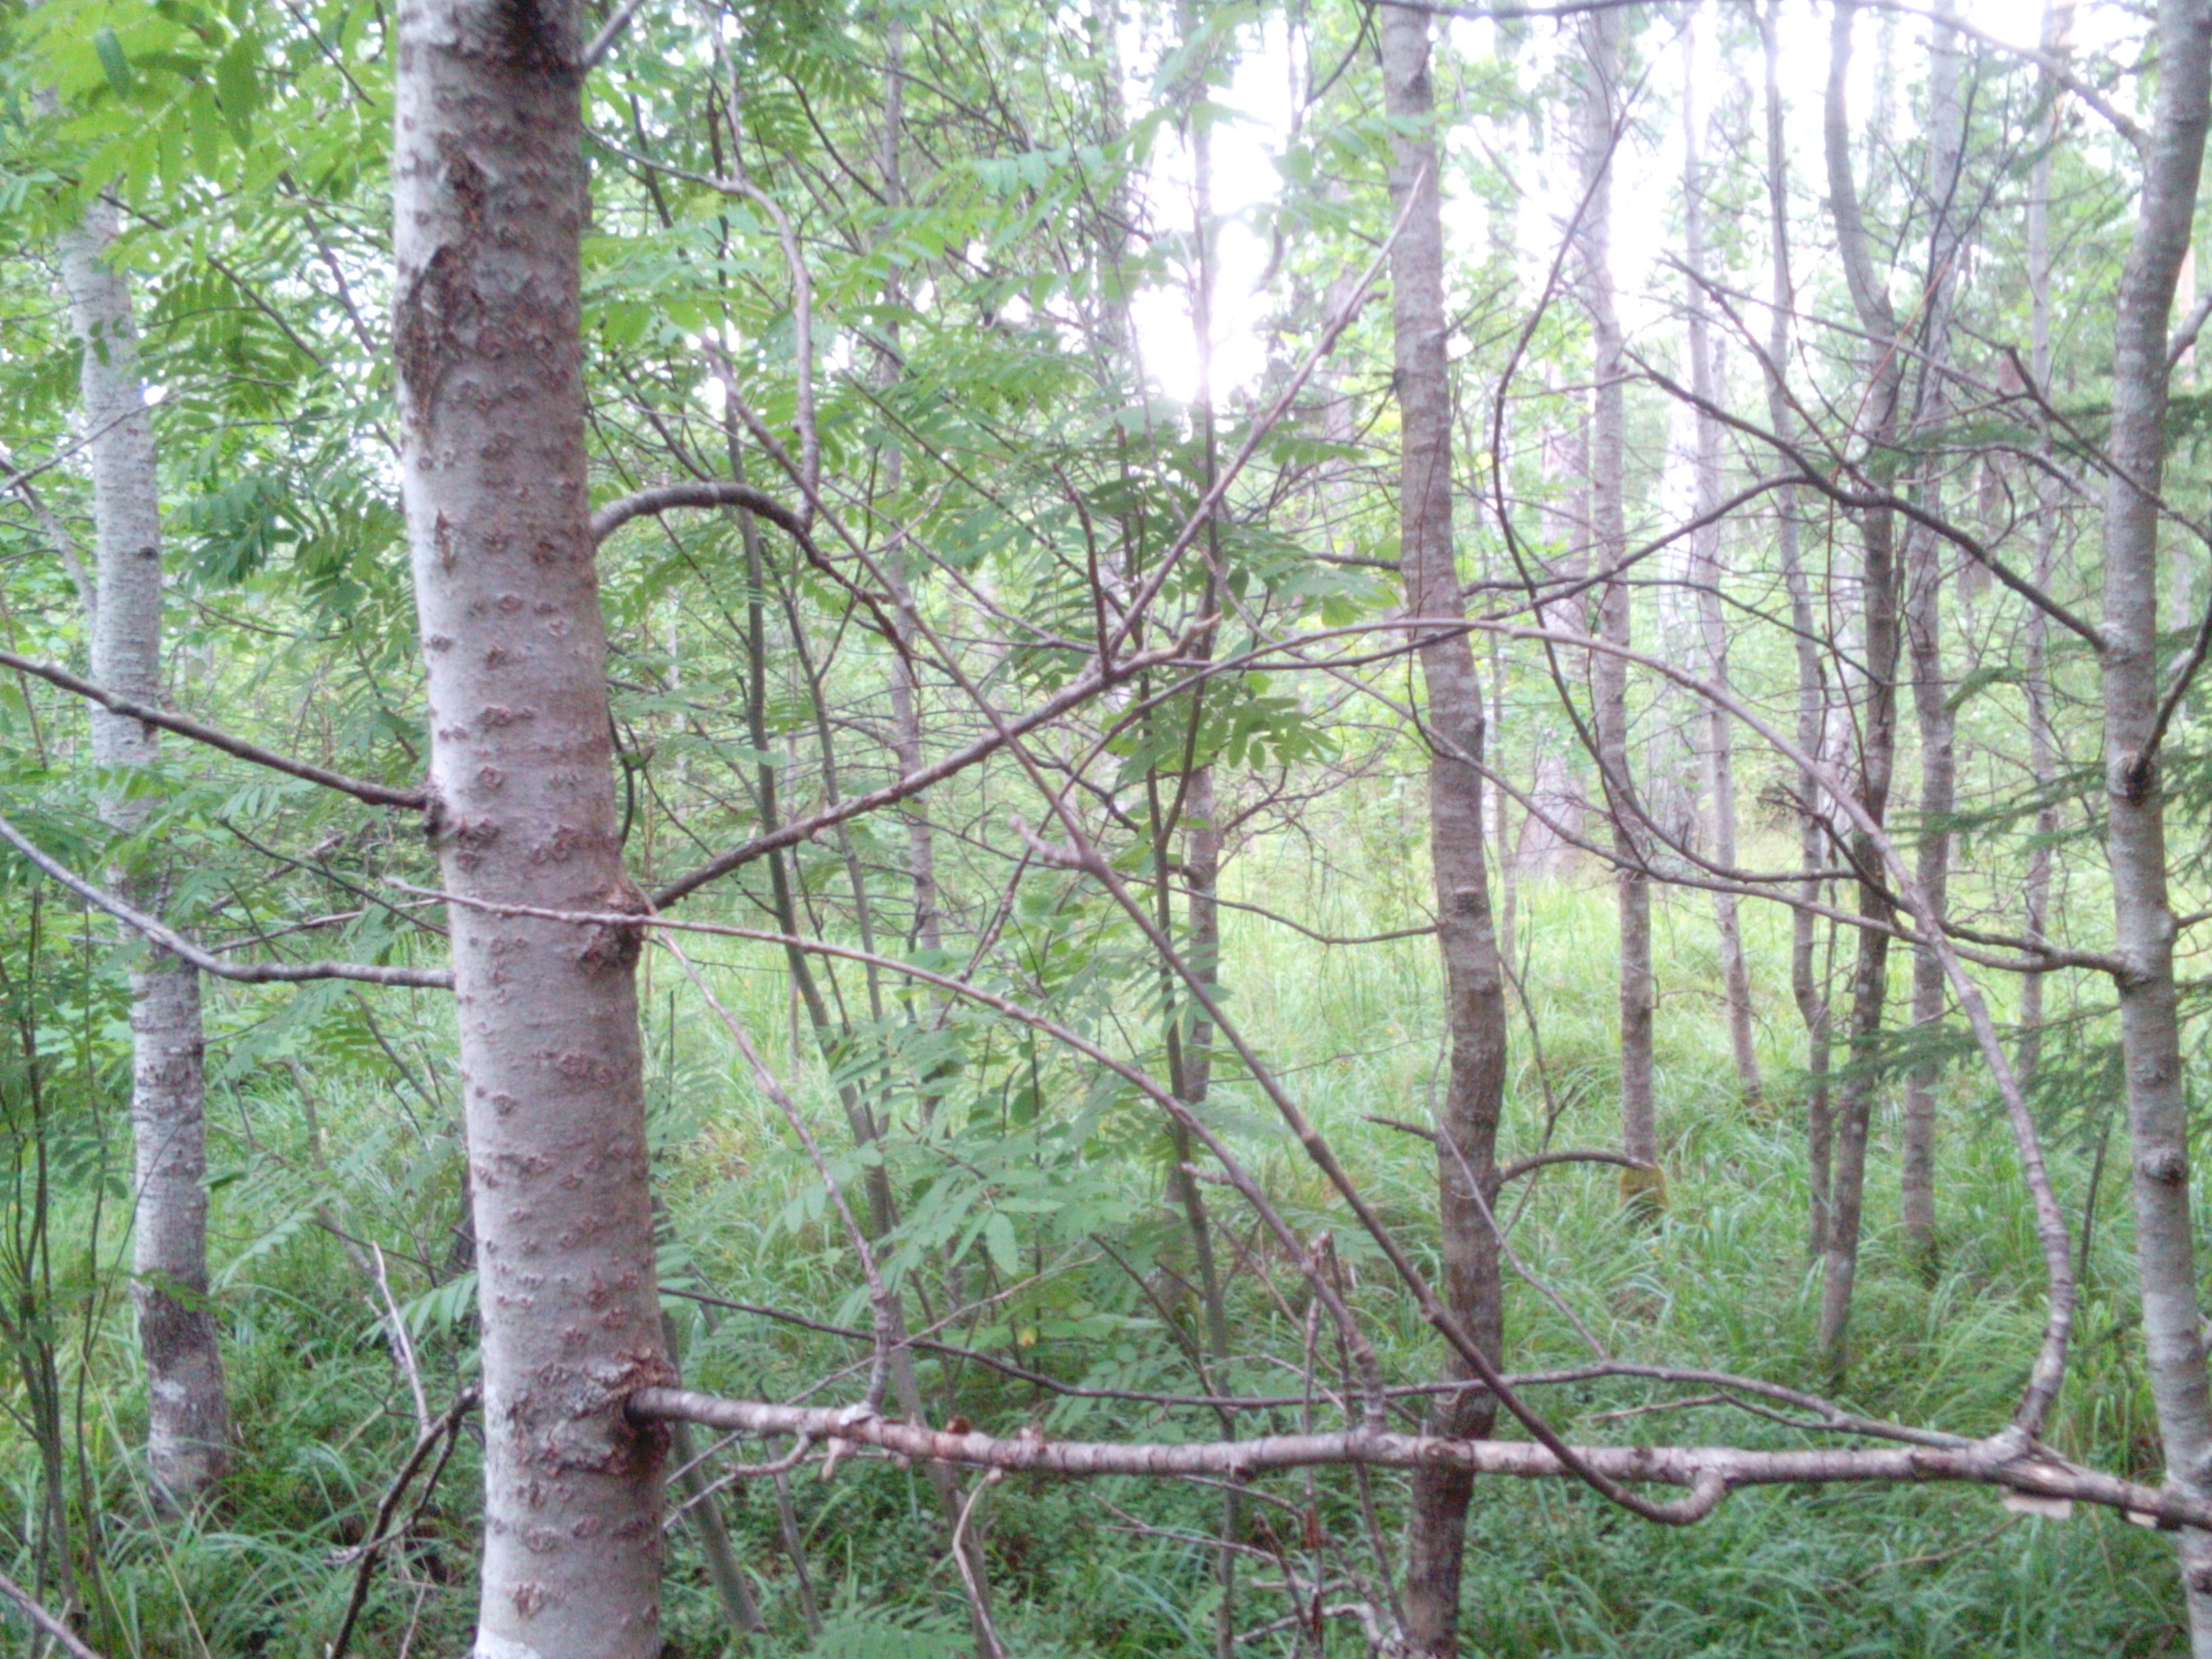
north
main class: Woodland
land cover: Spruce dominated mixed woodland
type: hemiboreal forest and nemoral coniferous forest and mixed broadleaved-coniferous forest
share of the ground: > 75 %
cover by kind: broadleaved forest trees 55 %, coniferous forest trees 30 %, herbaceous plants 10 %, shrubs 5 %
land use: Forestry
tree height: > 5 m
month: July
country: LV
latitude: 56.9122
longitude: 22.2212
